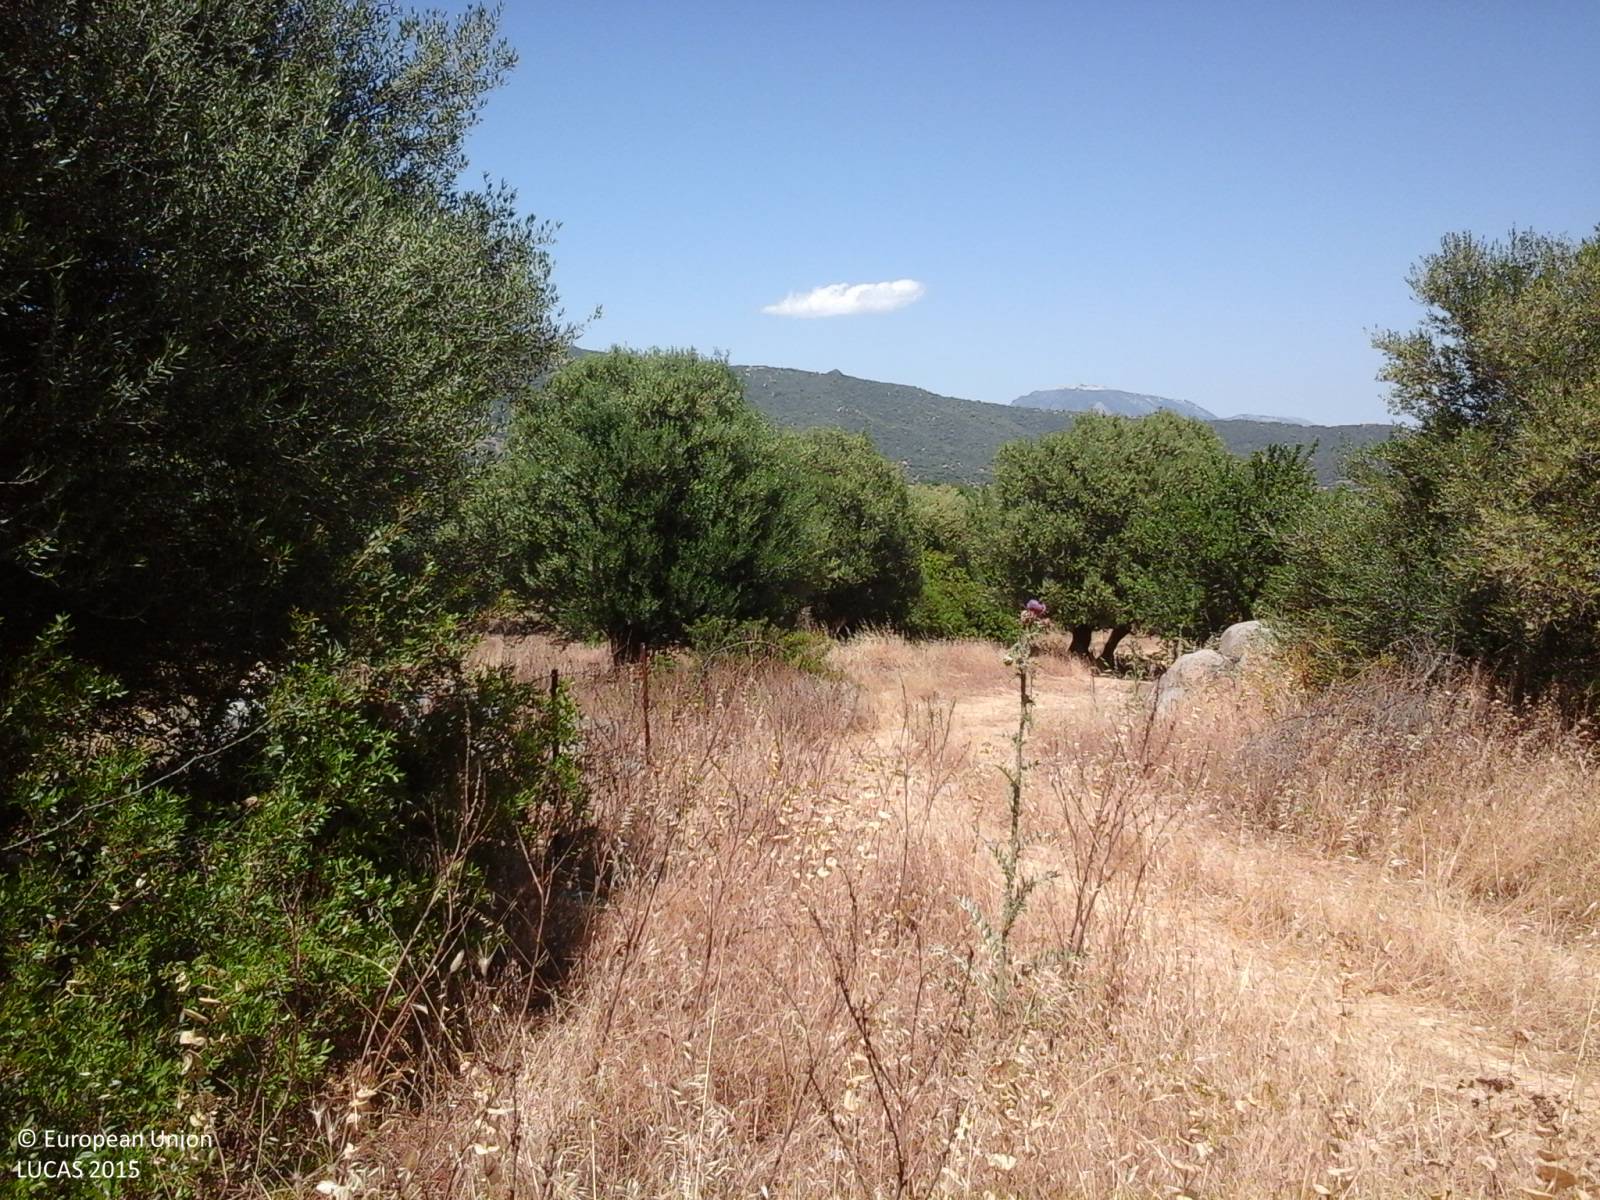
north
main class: Cropland
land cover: Olive groves
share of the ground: > 75 %
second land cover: Grassland without tree/shrub cover
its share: > 75 %
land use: Agriculture (excluding fallow land and kitchen gardens)
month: May
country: IT
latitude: 40.3202
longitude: 9.4732
